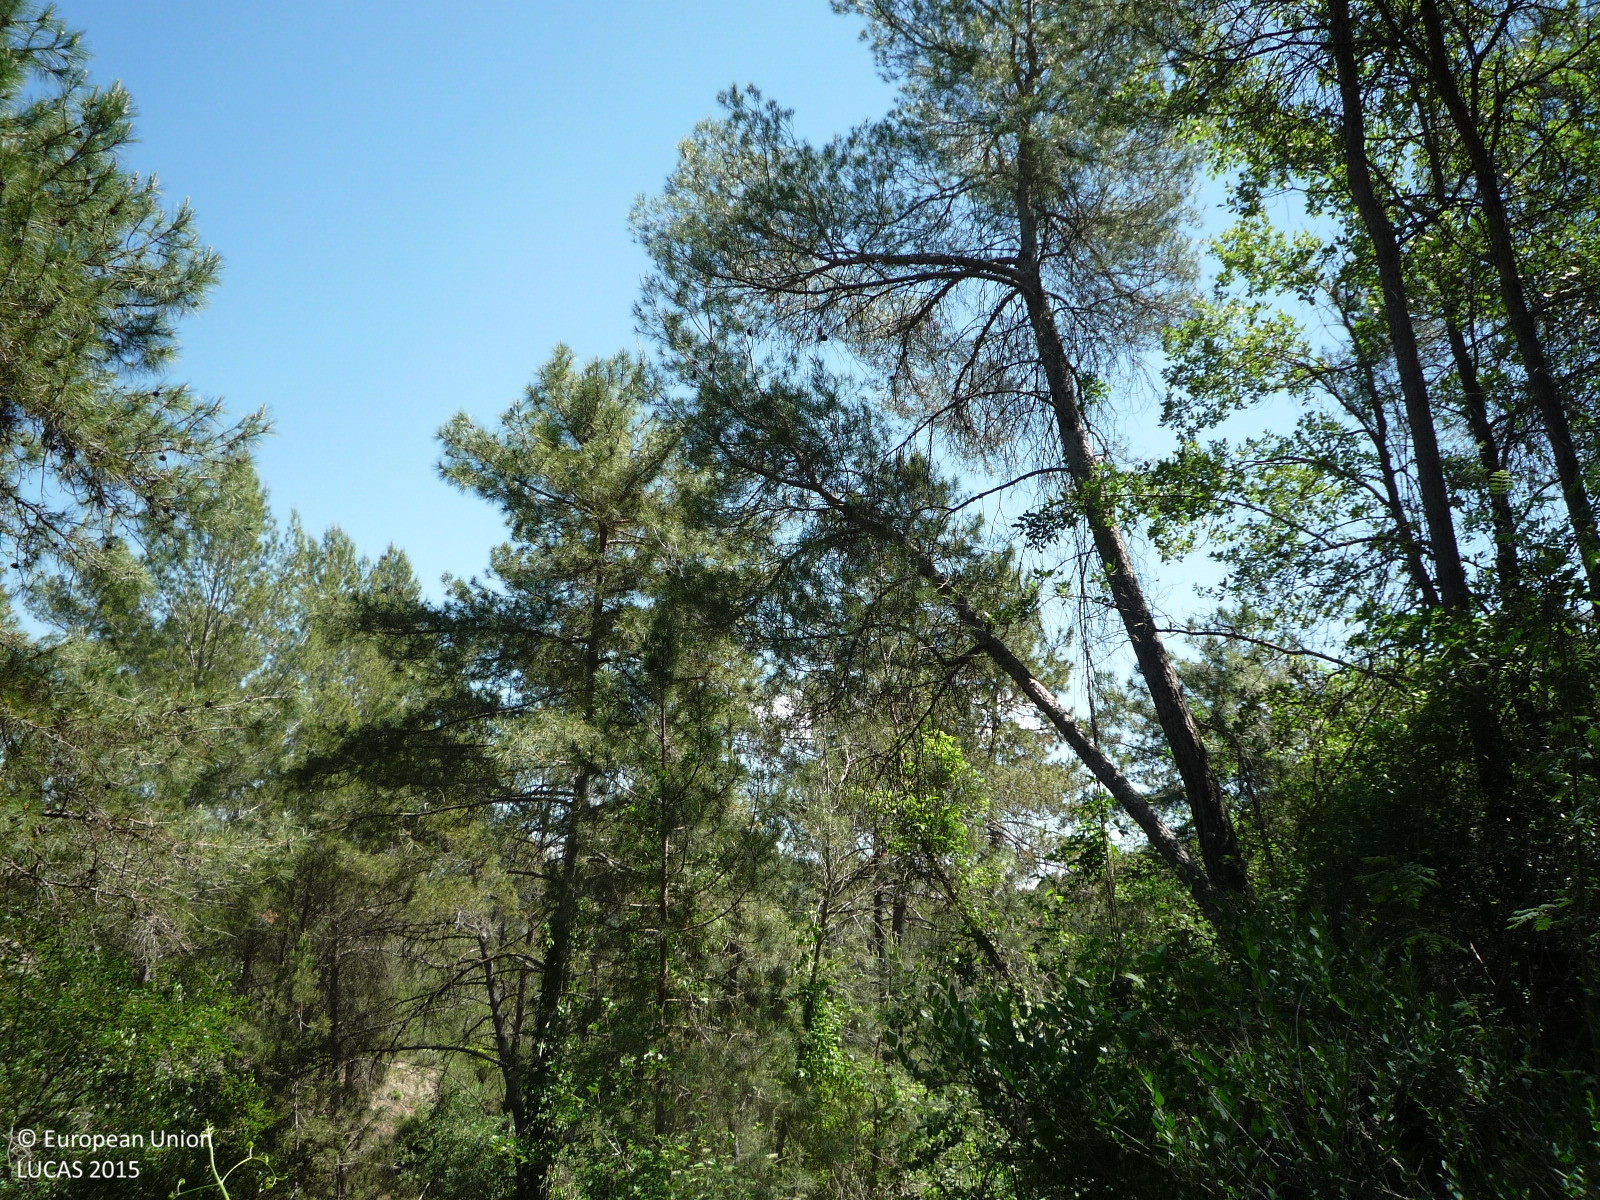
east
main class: Woodland
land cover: Pine dominated mixed woodland
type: coniferous forest of the mediterranean region
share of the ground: > 75 %
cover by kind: coniferous forest trees 70 %, broadleaved forest trees 25 %, shrubs 5 %
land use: Semi-natural and natural areas not in use
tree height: > 5 m
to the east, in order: Pine dominated mixed woodland; Pine dominated coniferous woodland; Dry stone walls; Pine dominated coniferous woodland; Dry stone walls; Pine dominated coniferous woodland; Dry stone walls; Pine dominated coniferous woodland; Fences; Paved roads, cycling and walking lanes; Fences; Pine dominated coniferous woodland
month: May
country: ES
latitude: 41.8264
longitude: 1.7428
